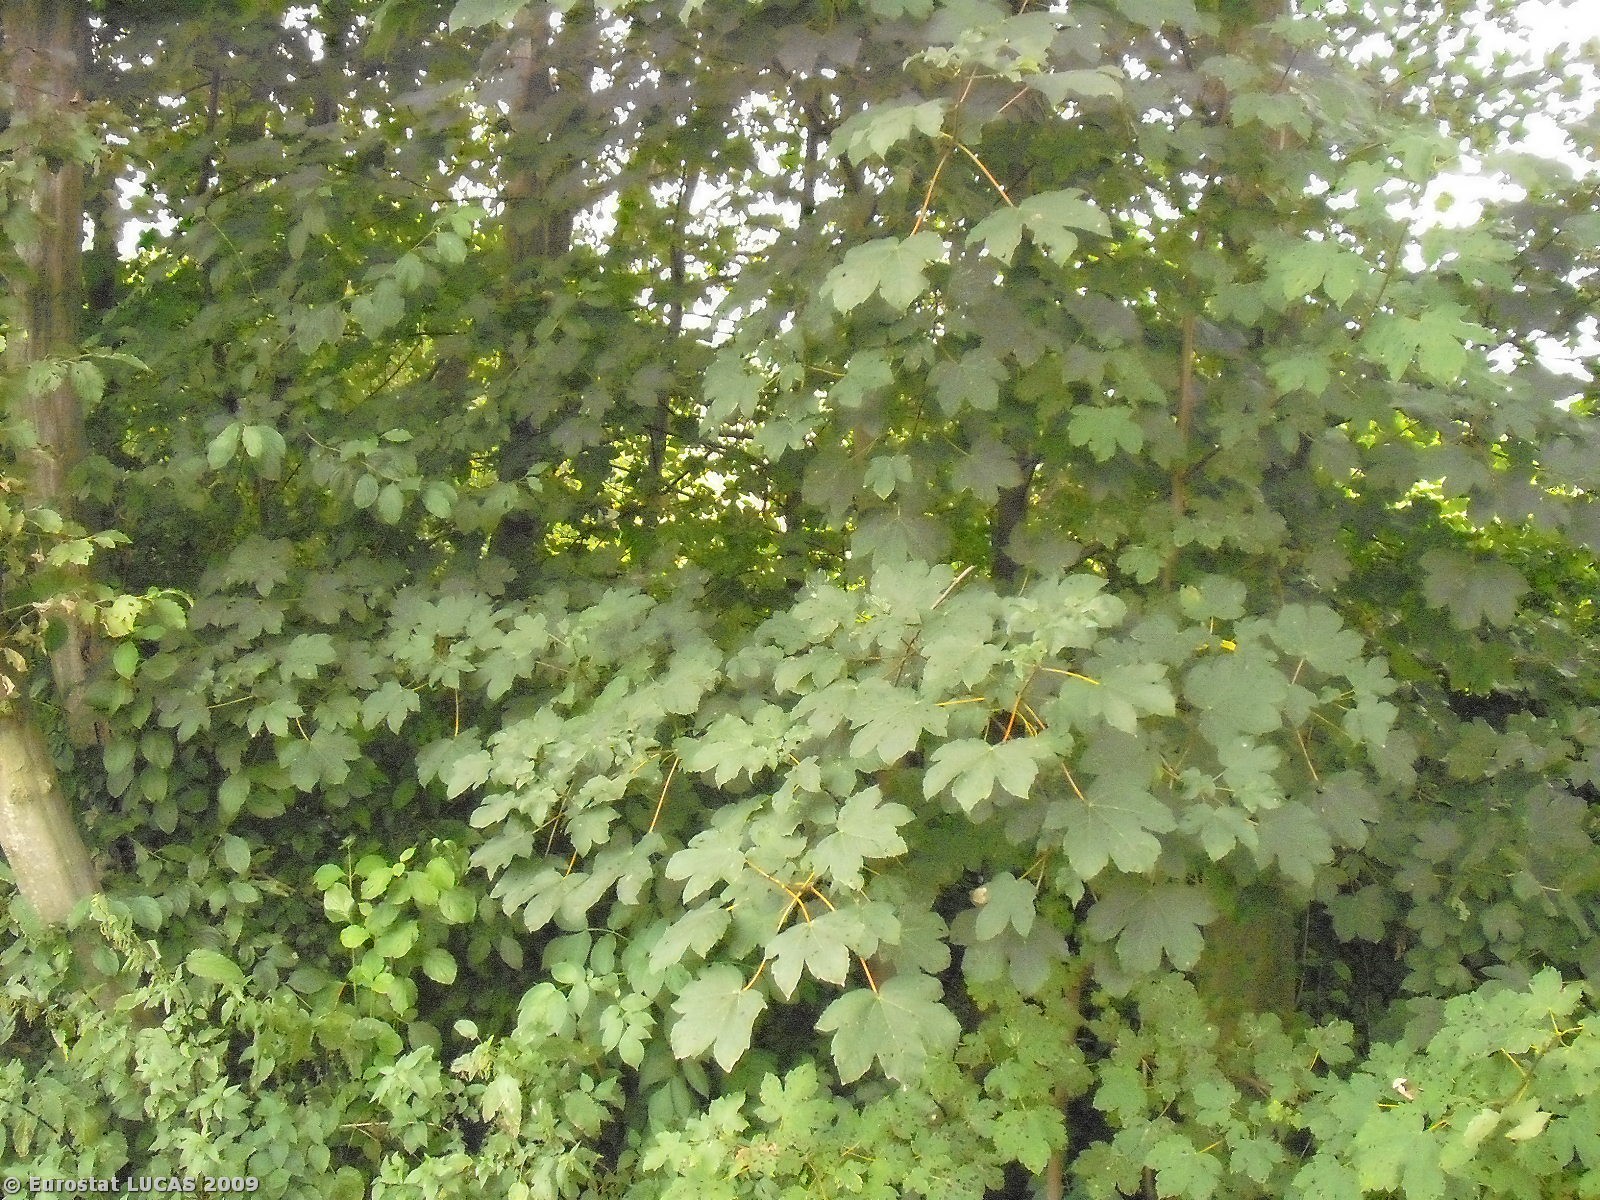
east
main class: Woodland
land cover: Broadleaved woodland
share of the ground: > 75 %
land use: Unused
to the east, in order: Broadleaved woodland; Ditches and canals; Broadleaved woodland; Grassland without tree/shrub cover; Grassland with sparse tree/shrub cover; Grassland without tree/shrub cover; Shrubland without tree cover; Grassland without tree/shrub cover; Shrubland without tree cover; Grassland without tree/shrub cover
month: August
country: PL
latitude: 49.8590
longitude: 22.3171
